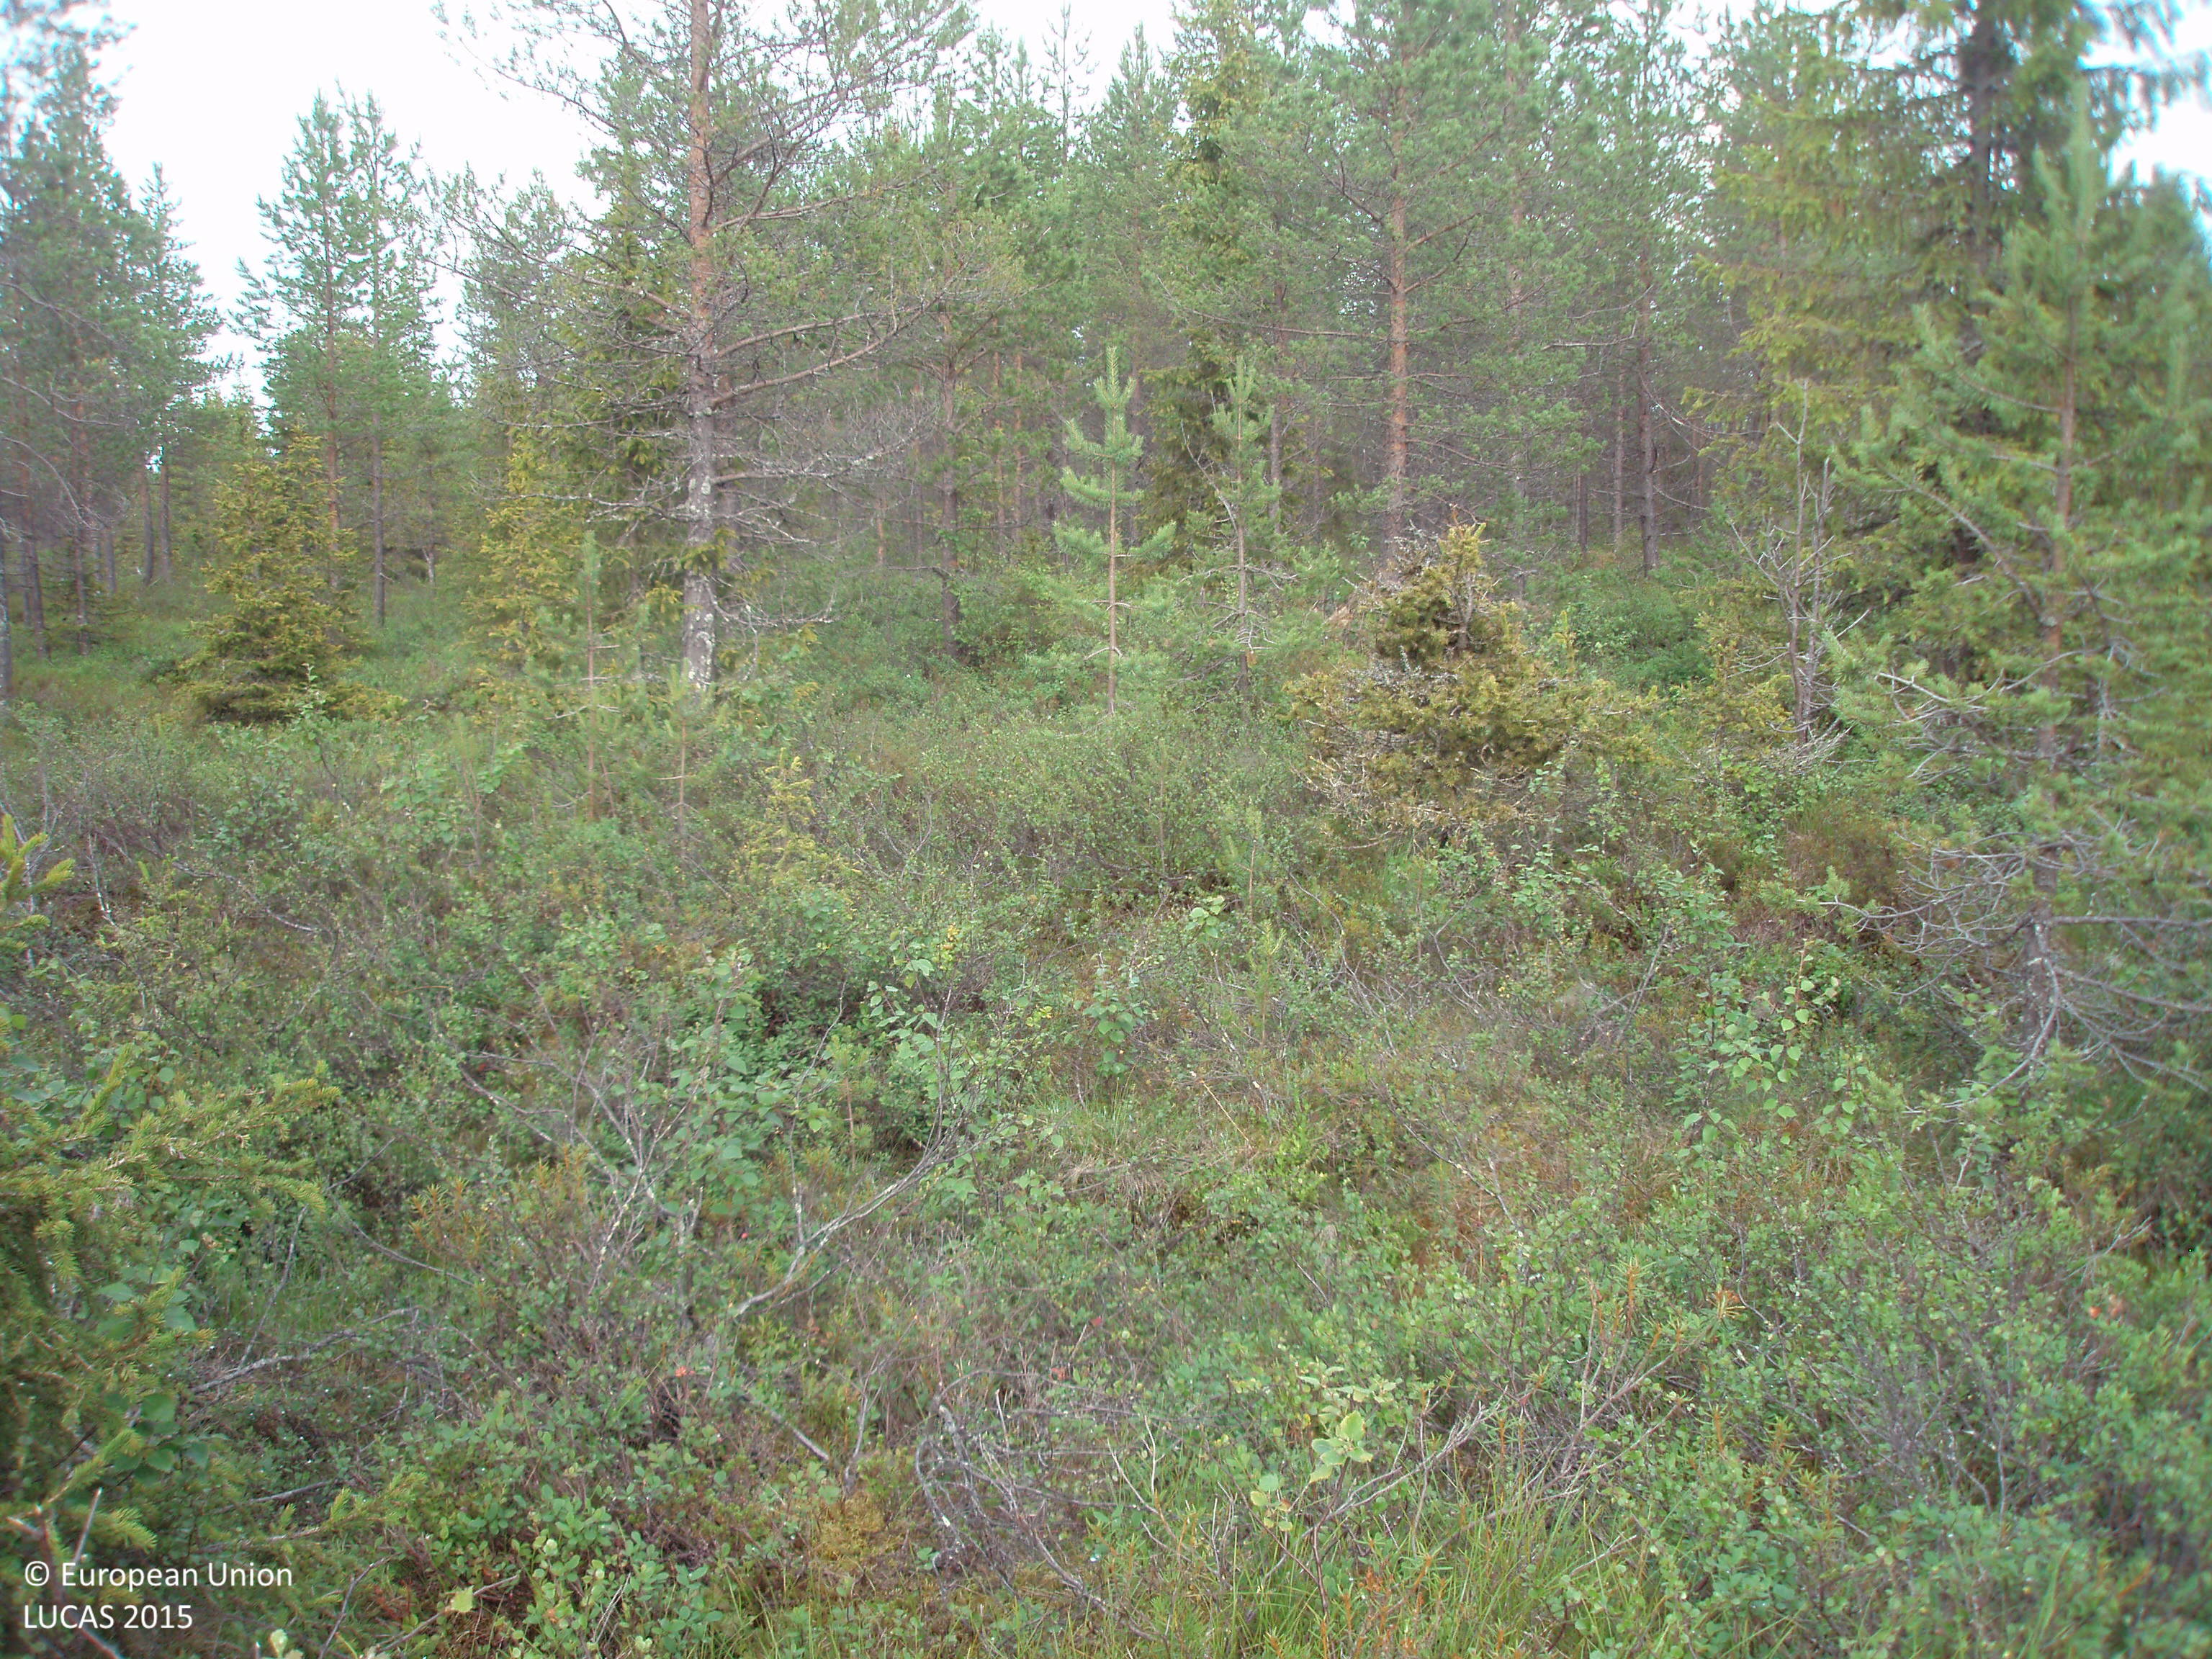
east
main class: Woodland
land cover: Pine dominated coniferous woodland
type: mire and swamp forests
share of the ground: 50 - 75 %
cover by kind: coniferous forest trees 60 %, shrubs 30 %, lichens and mosses 10 %
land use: Semi-natural and natural areas not in use
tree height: > 5 m
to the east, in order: Pine dominated coniferous woodland; Ditches and canals; Pine dominated coniferous woodland; Ditches and canals; Pine dominated coniferous woodland; Ditches and canals; Pine dominated coniferous woodland; Ditches and canals; Pine dominated coniferous woodland; Ditches and canals; Pine dominated coniferous woodland; Ditches and canals; Pine dominated coniferous woodland; Ditches and canals; Other coniferous woodland
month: July
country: FI
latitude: 65.8430
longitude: 27.9416
